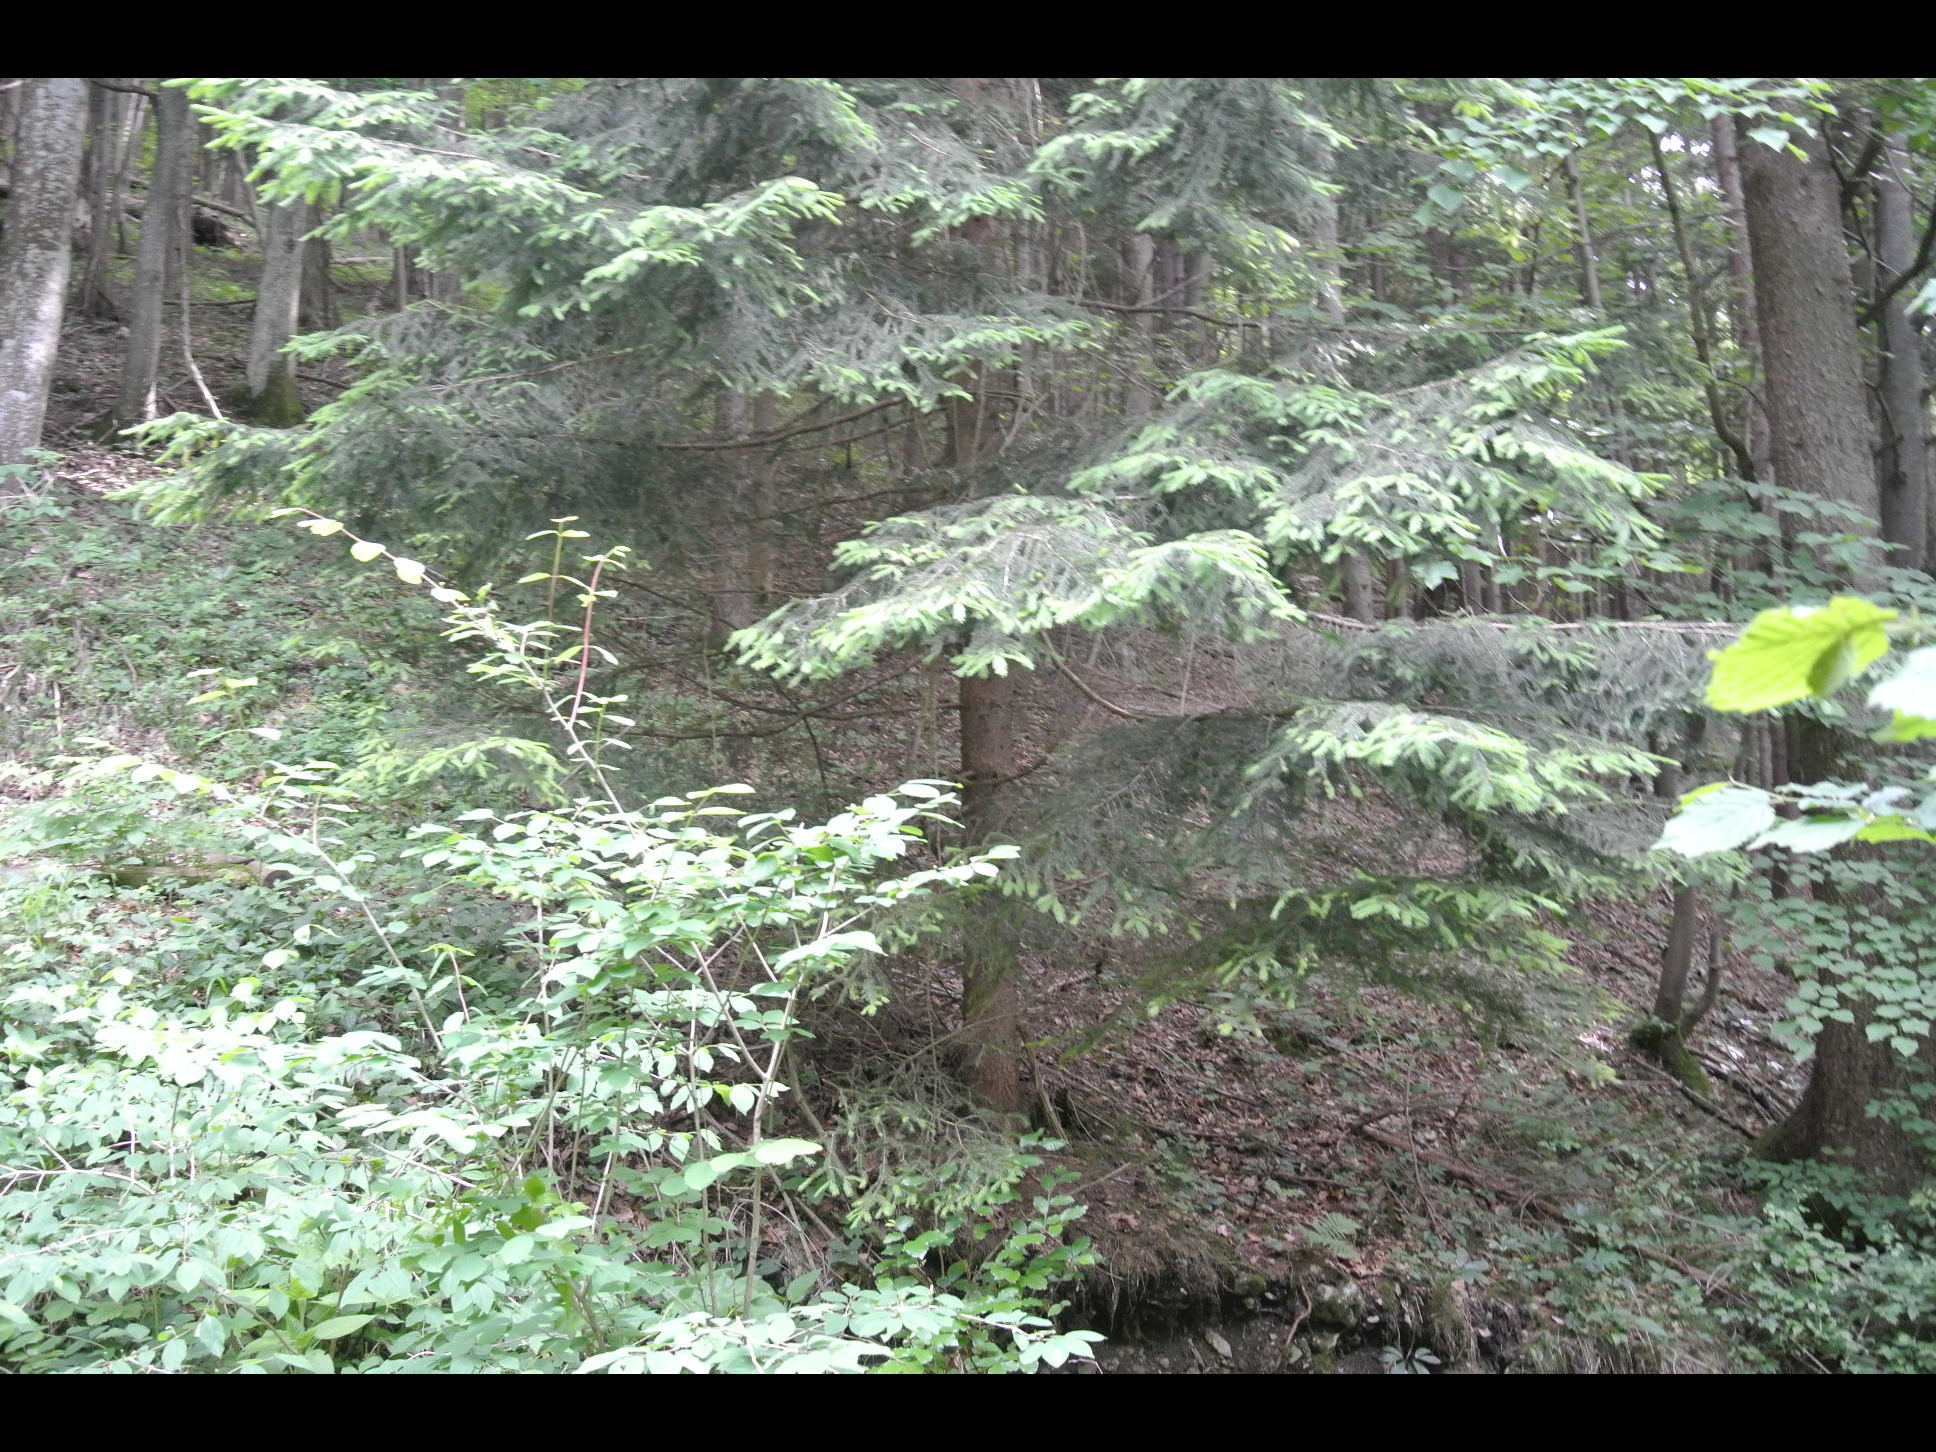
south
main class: Woodland
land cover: Spruce dominated coniferous woodland
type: alpine coniferous forest
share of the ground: > 75 %
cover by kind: coniferous forest trees 100 %
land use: Forestry
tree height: > 5 m
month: May
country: AT
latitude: 47.9833
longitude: 15.7504
